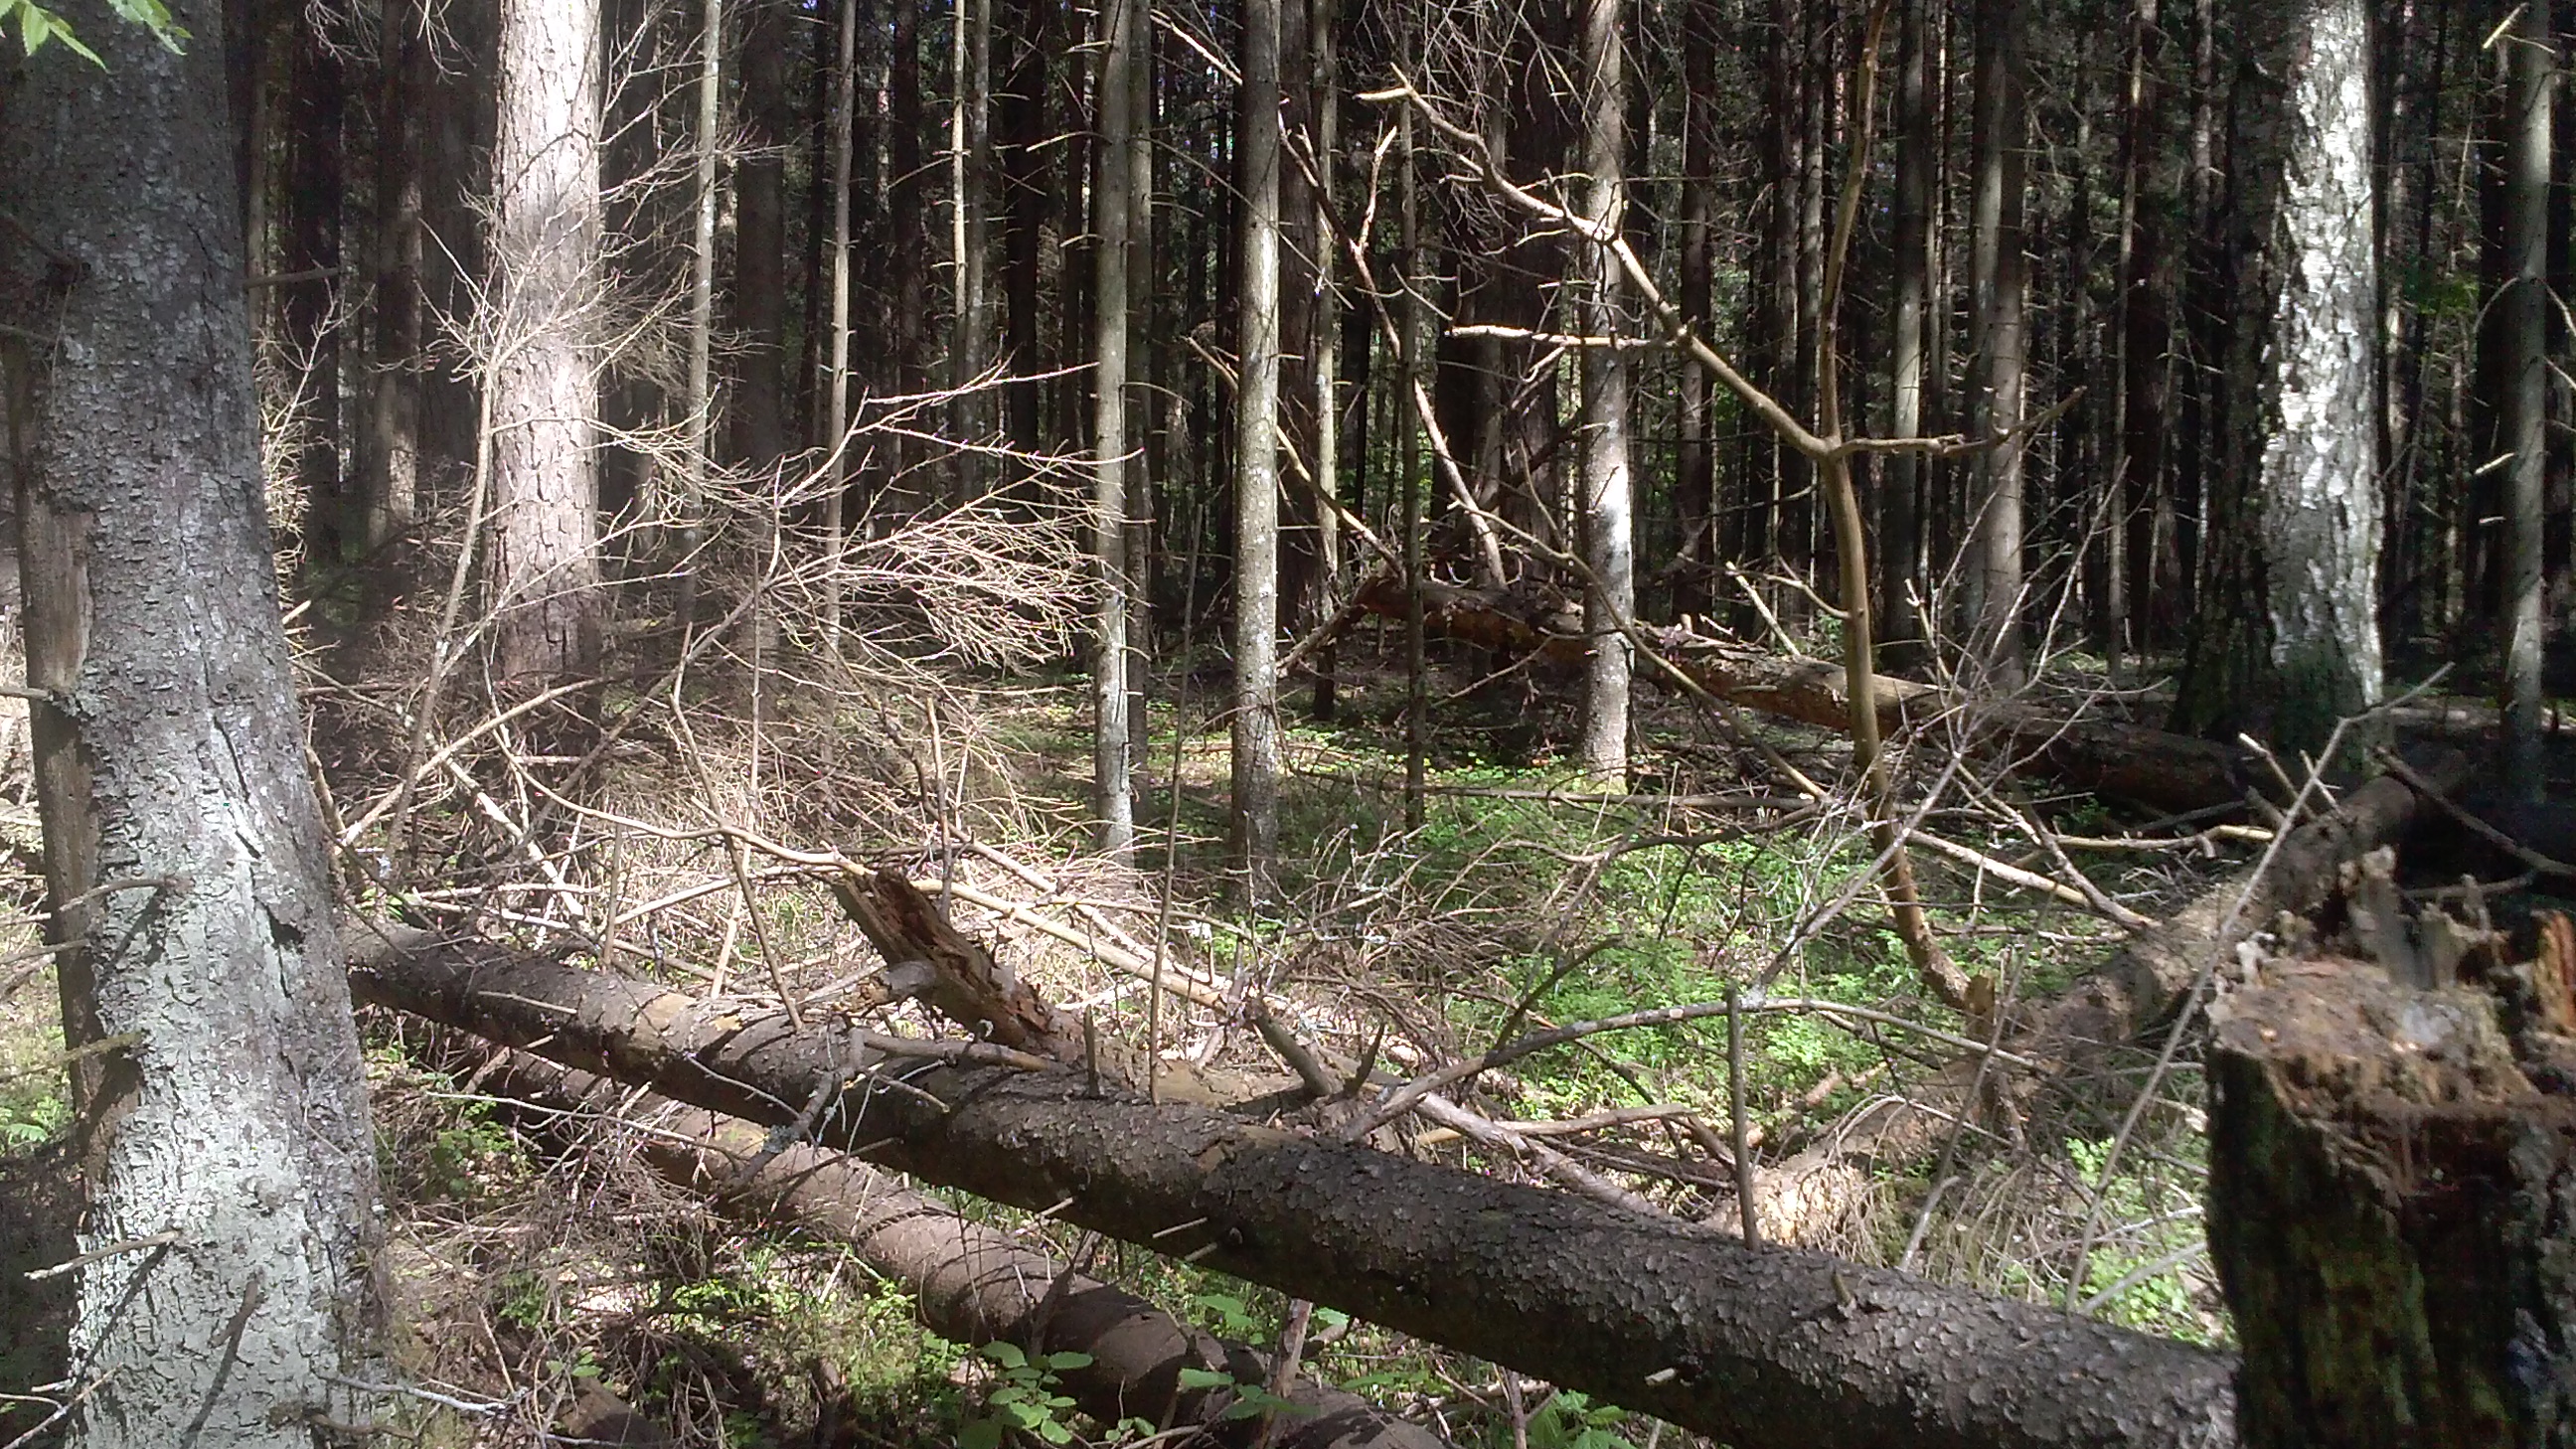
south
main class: Woodland
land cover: Spruce dominated coniferous woodland
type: hemiboreal forest and nemoral coniferous forest and mixed broadleaved-coniferous forest
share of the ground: > 75 %
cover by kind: coniferous forest trees 95 %, broadleaved forest trees 5 %
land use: Forestry
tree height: > 5 m
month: May
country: LV
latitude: 56.2835
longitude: 27.2126
